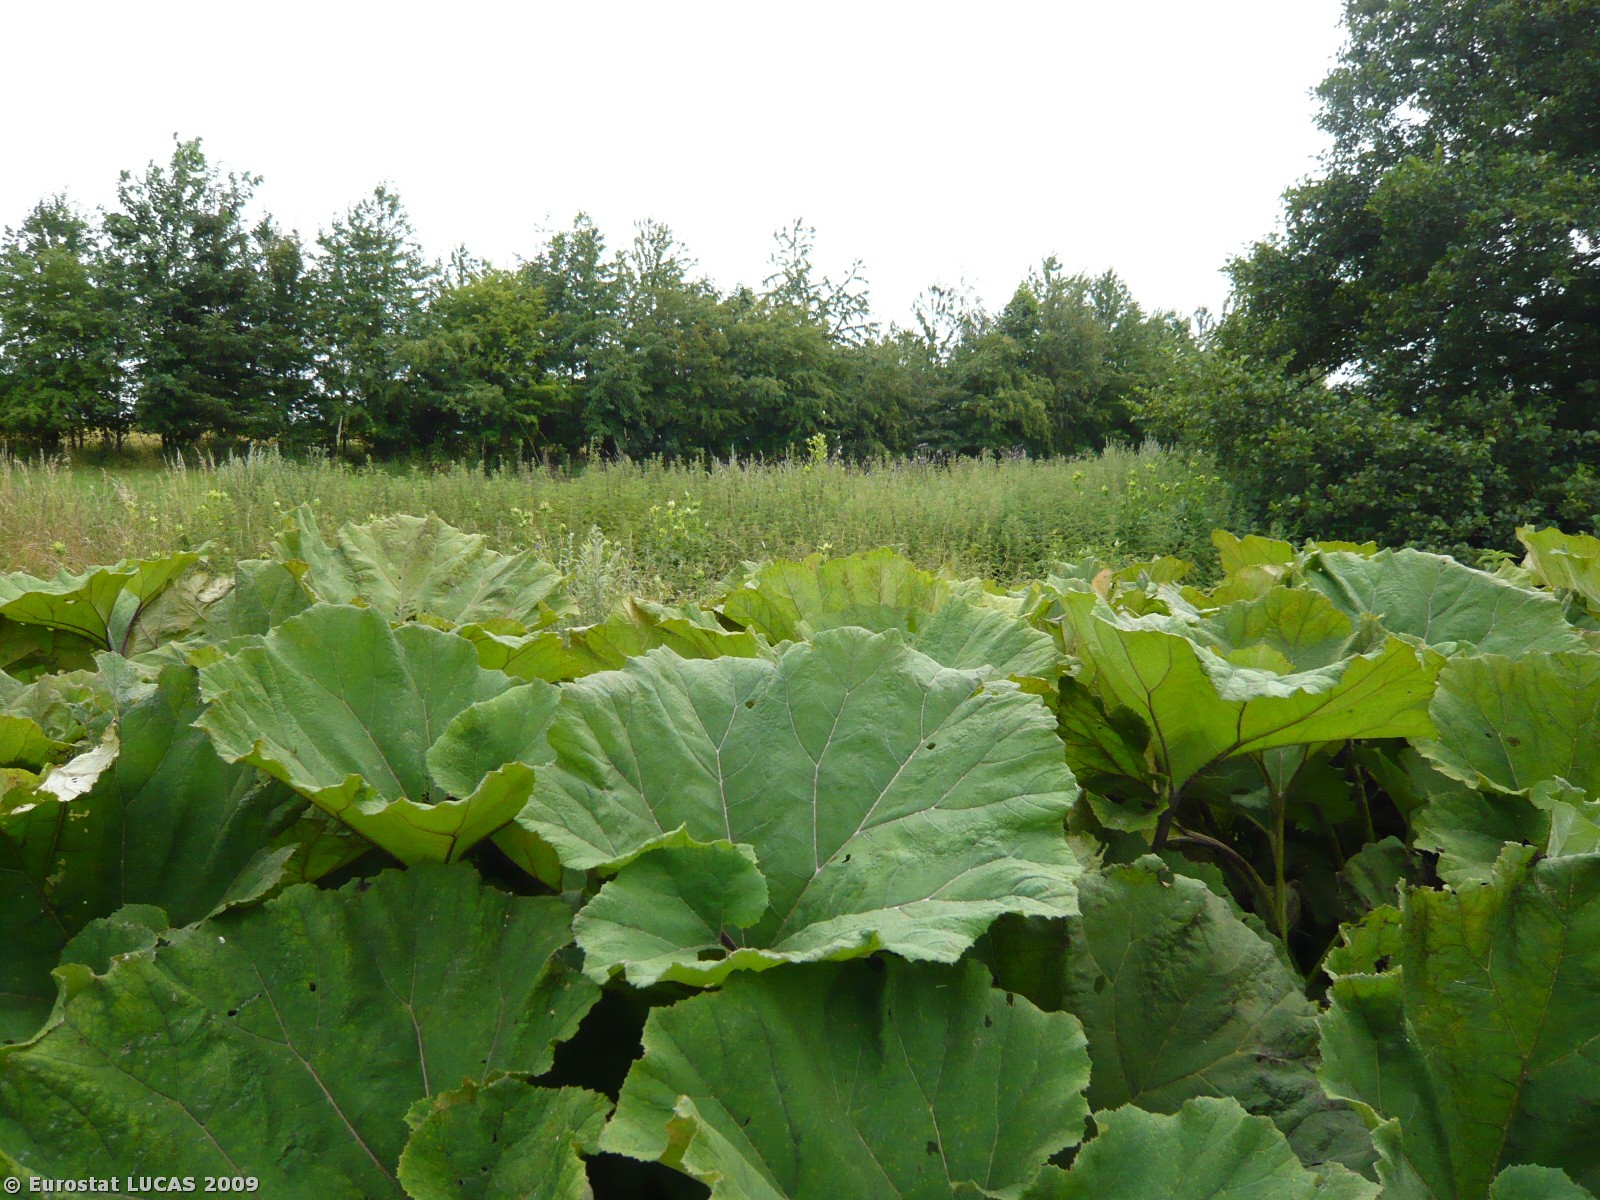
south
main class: Grassland
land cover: Grassland without tree/shrub cover
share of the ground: > 75 %
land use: Agriculture (excluding fallow land and kitchen gardens)
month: July
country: DK
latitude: 55.5285
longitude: 11.7570
